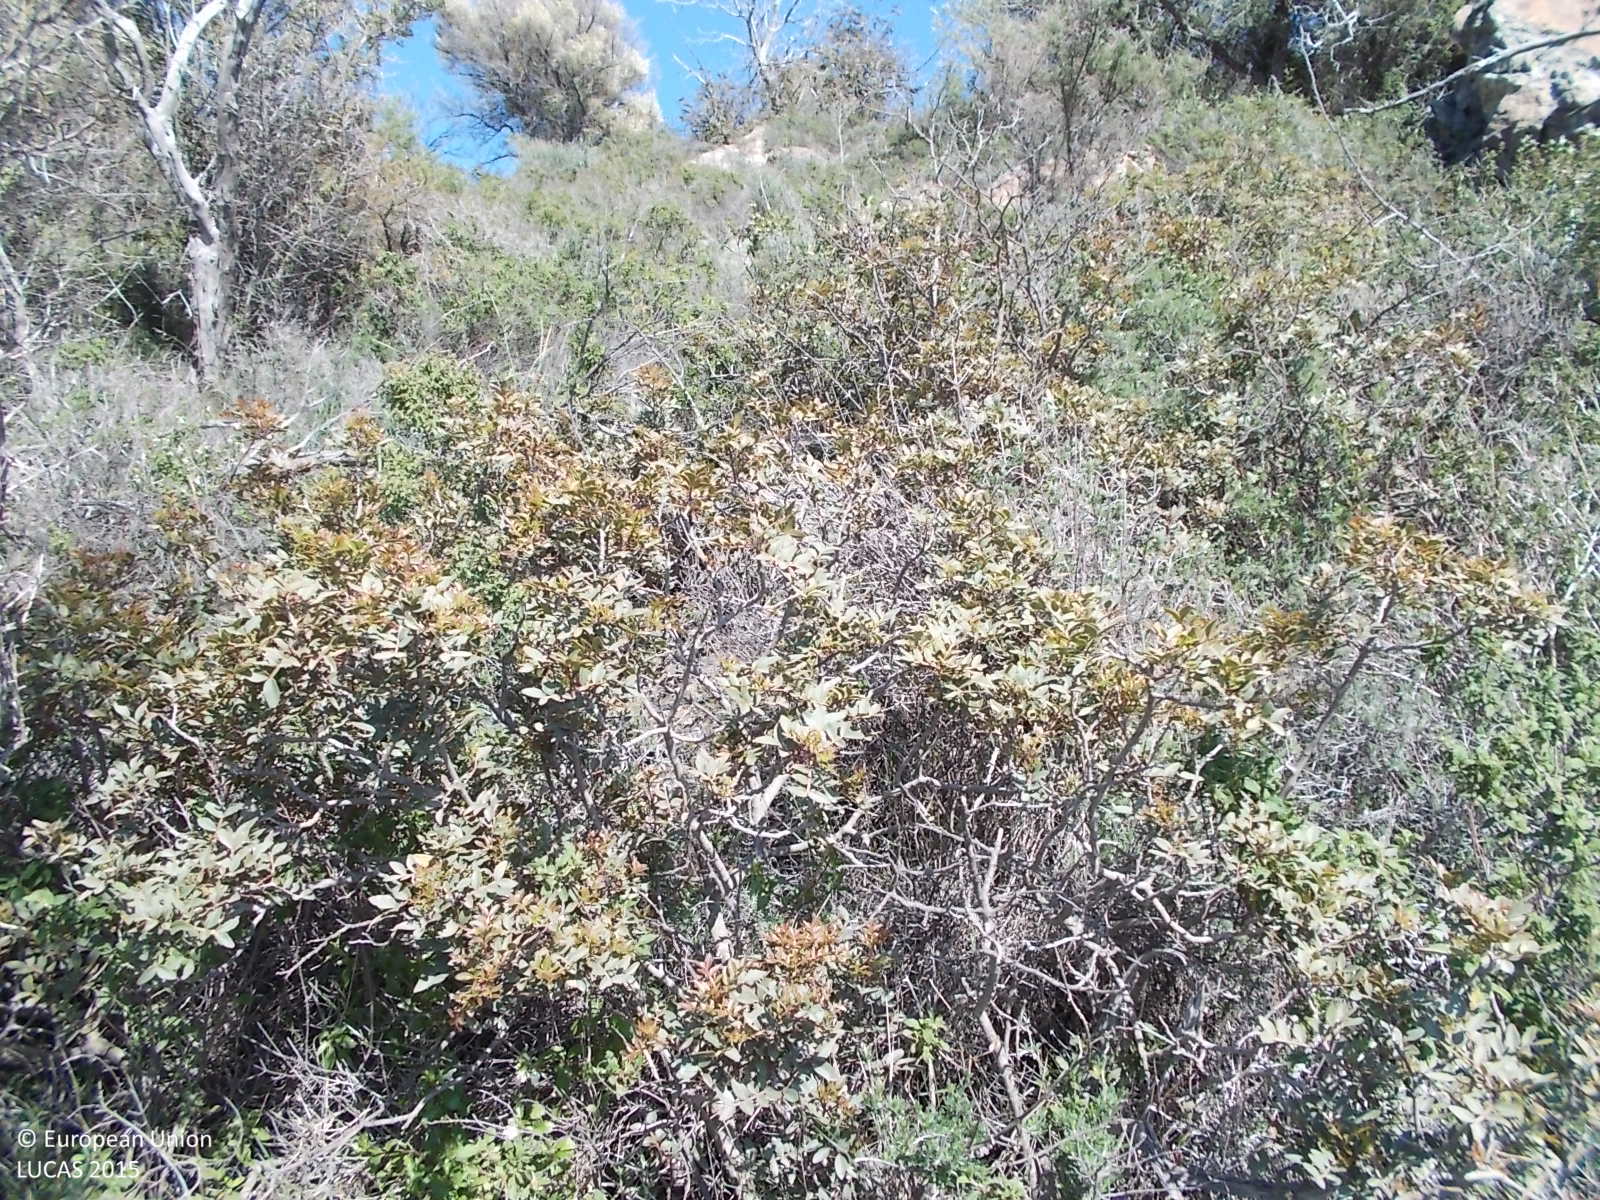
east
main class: Woodland
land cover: Other mixed woodland
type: coniferous forest of the mediterranean region
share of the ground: > 75 %
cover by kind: shrubs 60 %, coniferous forest trees 20 %, broadleaved forest trees 20 %
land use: Semi-natural and natural areas not in use
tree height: < 5 m
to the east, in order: Other mixed woodland; Shrubland with sparse tree cover; Other mixed woodland; Shrubland with sparse tree cover
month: April
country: CY
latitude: 34.8075
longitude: 33.0938
